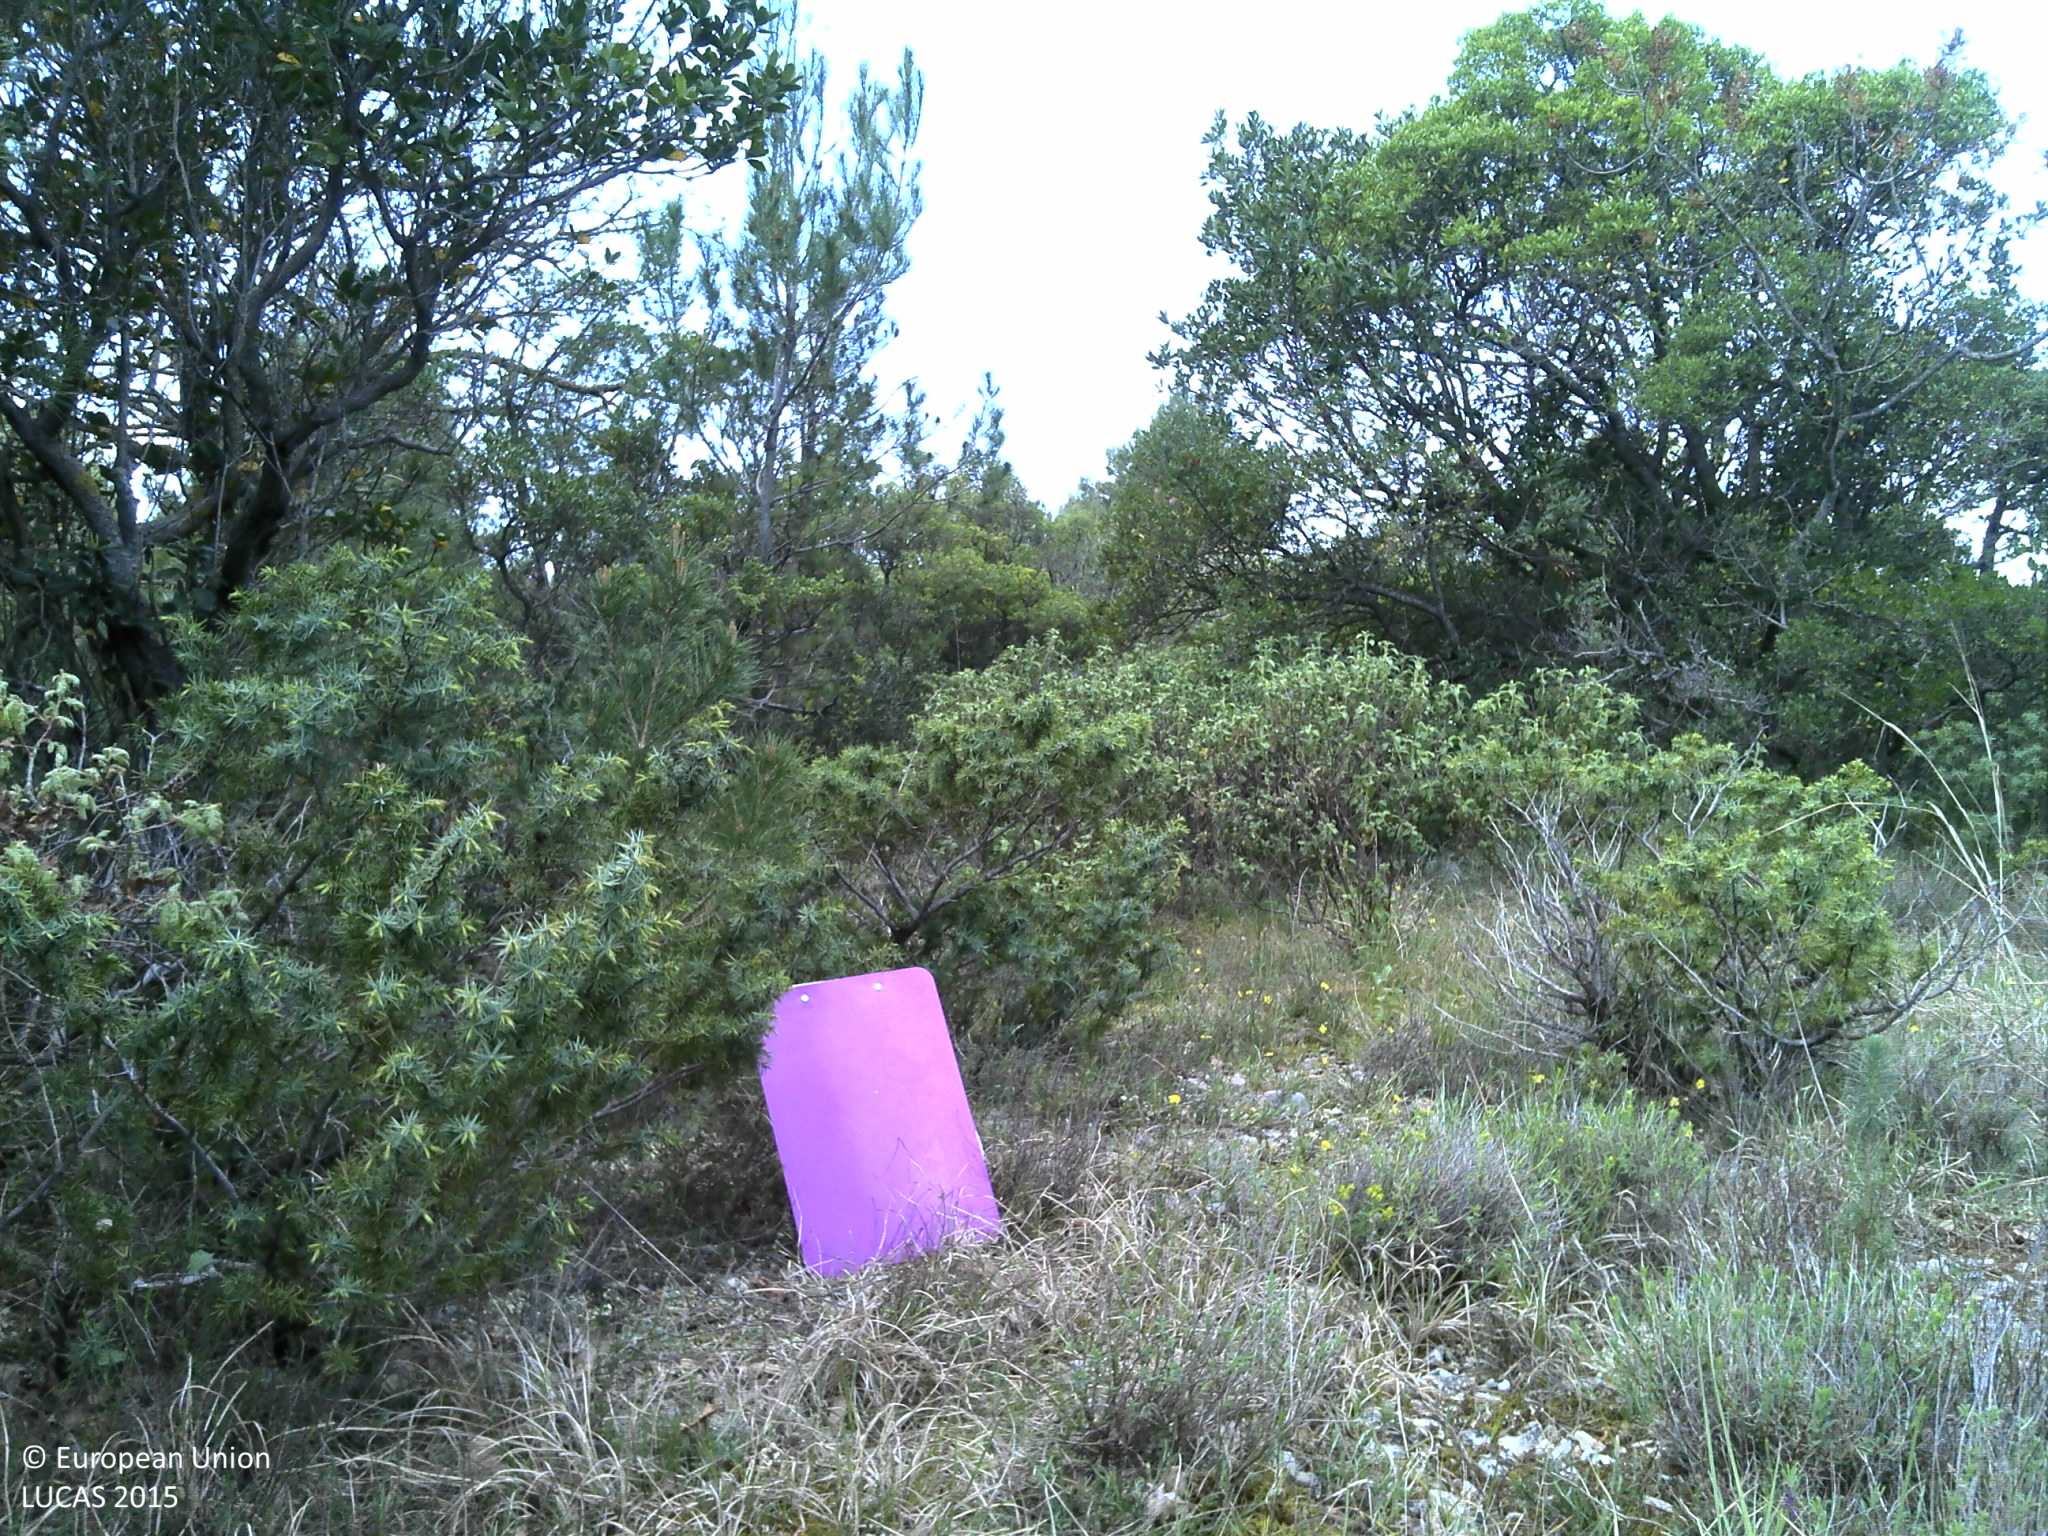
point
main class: Woodland
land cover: Pine dominated coniferous woodland
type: coniferous forest of the mediterranean region
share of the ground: 50 - 75 %
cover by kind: coniferous forest trees 50 %, shrubs 20 %, herbaceous plants 20 %, broadleaved forest trees 5 %, unconsolidated bare surface 5 %
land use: Semi-natural and natural areas not in use
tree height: > 5 m
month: April
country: HR
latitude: 43.7270
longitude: 15.9623
